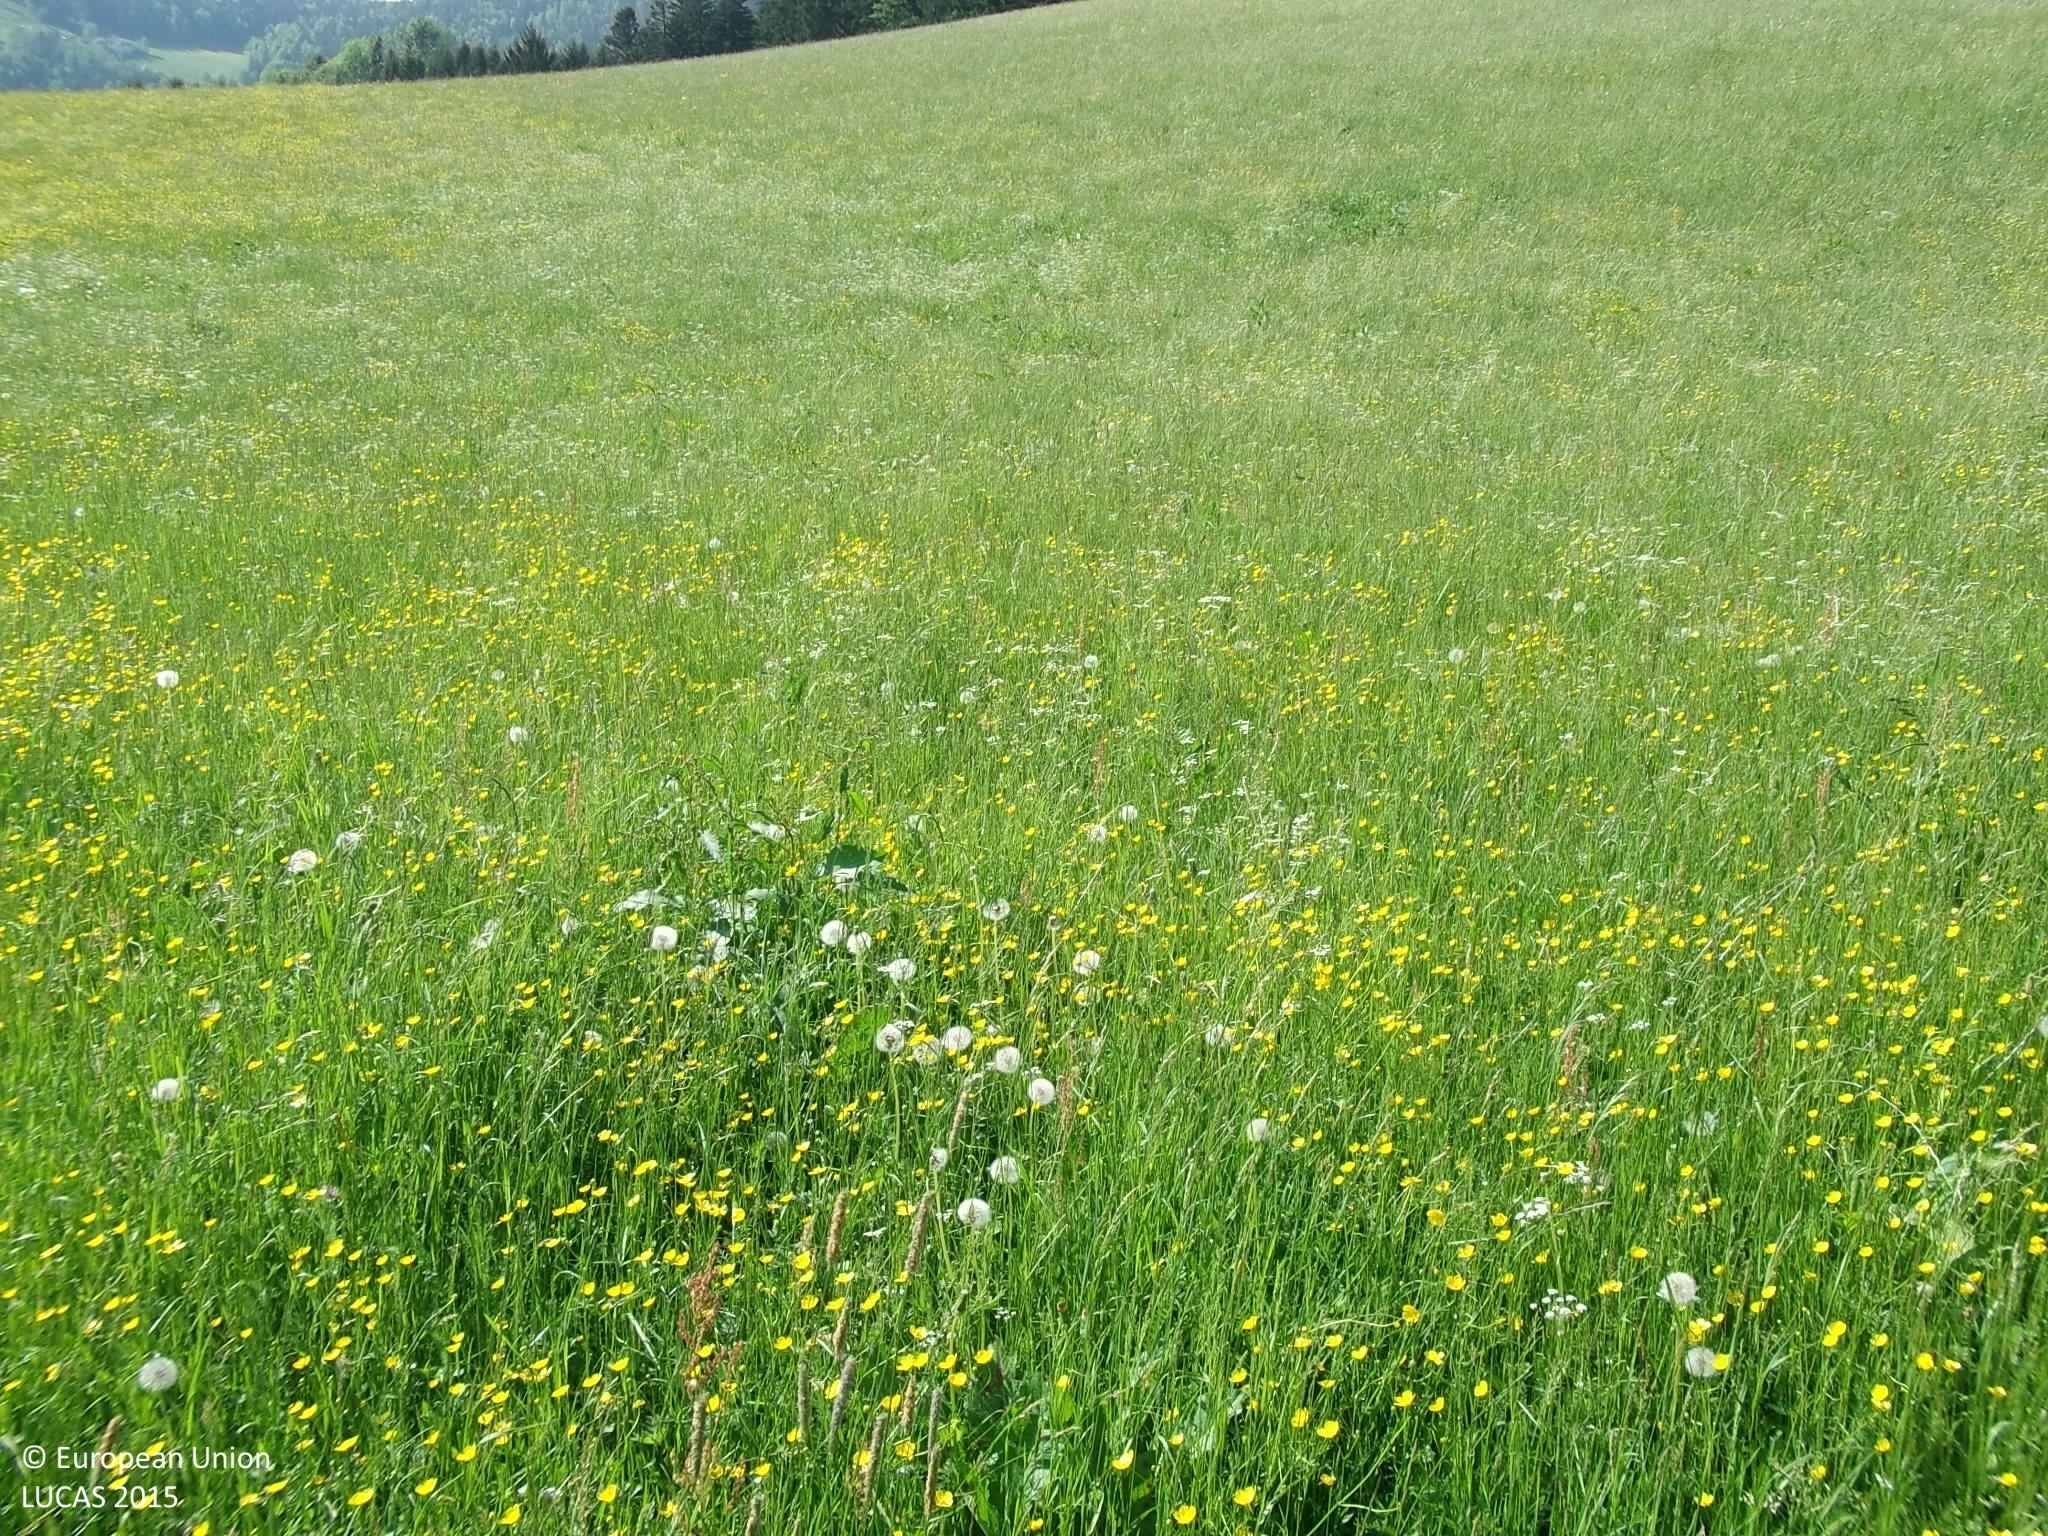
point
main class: Grassland
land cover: Grassland without tree/shrub cover
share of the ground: > 75 %
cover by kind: herbaceous plants 100 %
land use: Agriculture (excluding fallow land and kitchen gardens)
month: May
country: AT
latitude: 47.5975
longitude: 13.3101
